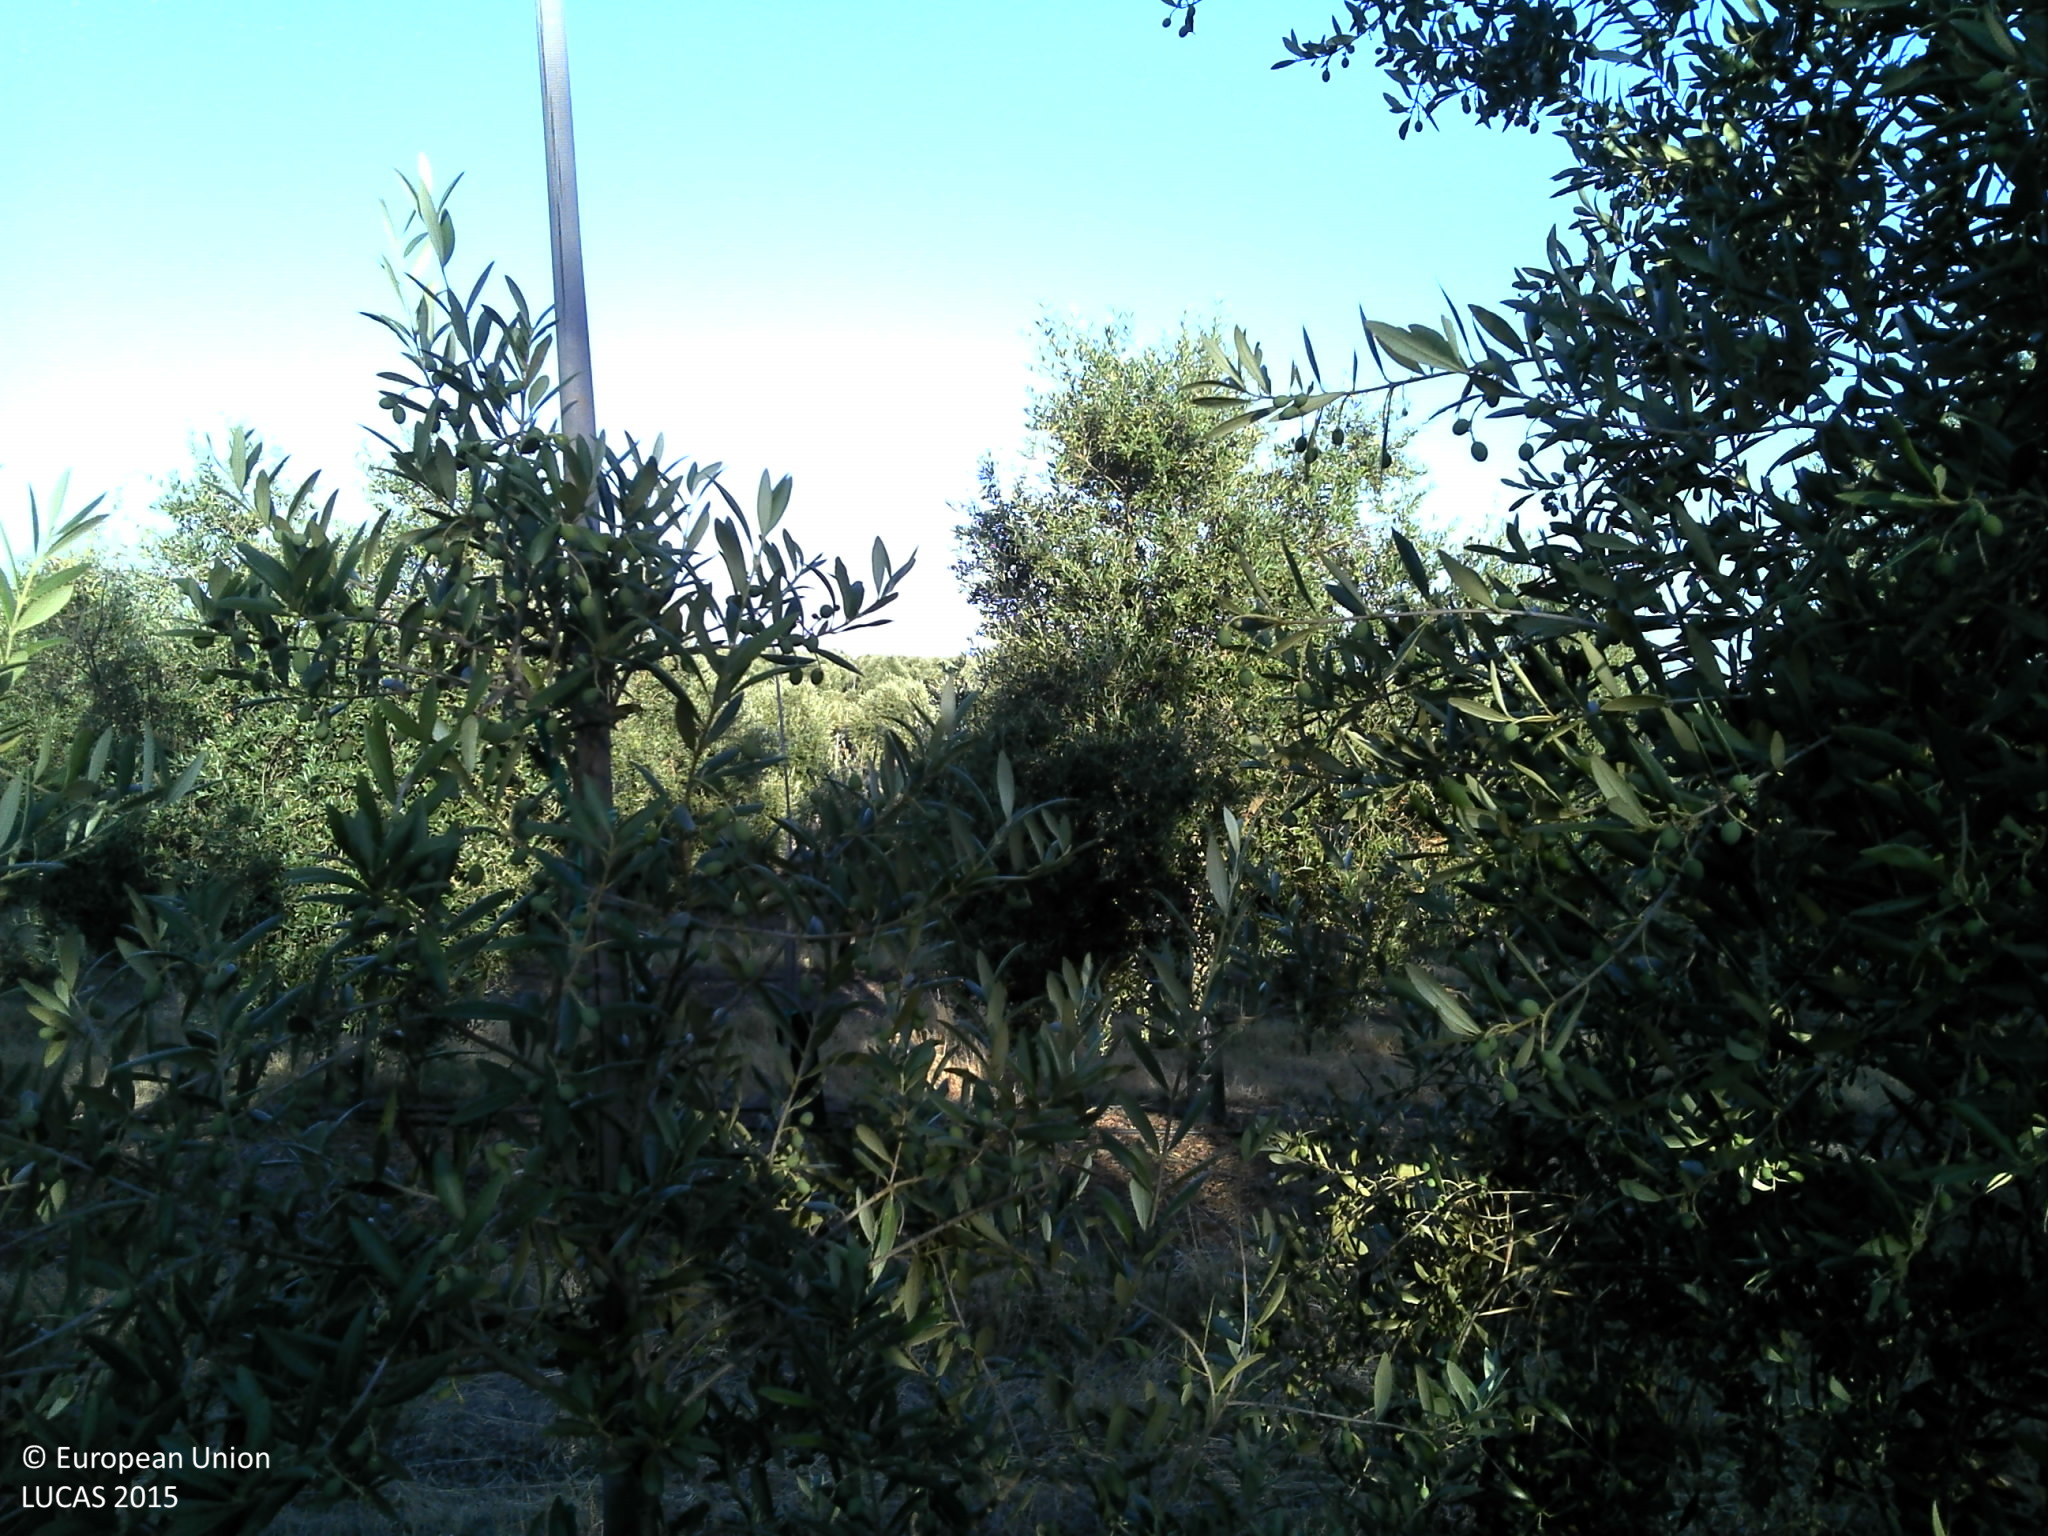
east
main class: Cropland
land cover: Olive groves
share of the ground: 25 - 50 %
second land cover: Spontaneously vegetated surfaces
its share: 10 - 25 %
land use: Agriculture (excluding fallow land and kitchen gardens)
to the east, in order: Olive groves; Spontaneously vegetated surfaces; Olive groves; Rivers and streams; Olive groves
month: June
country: PT
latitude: 38.1604
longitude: -8.1029
